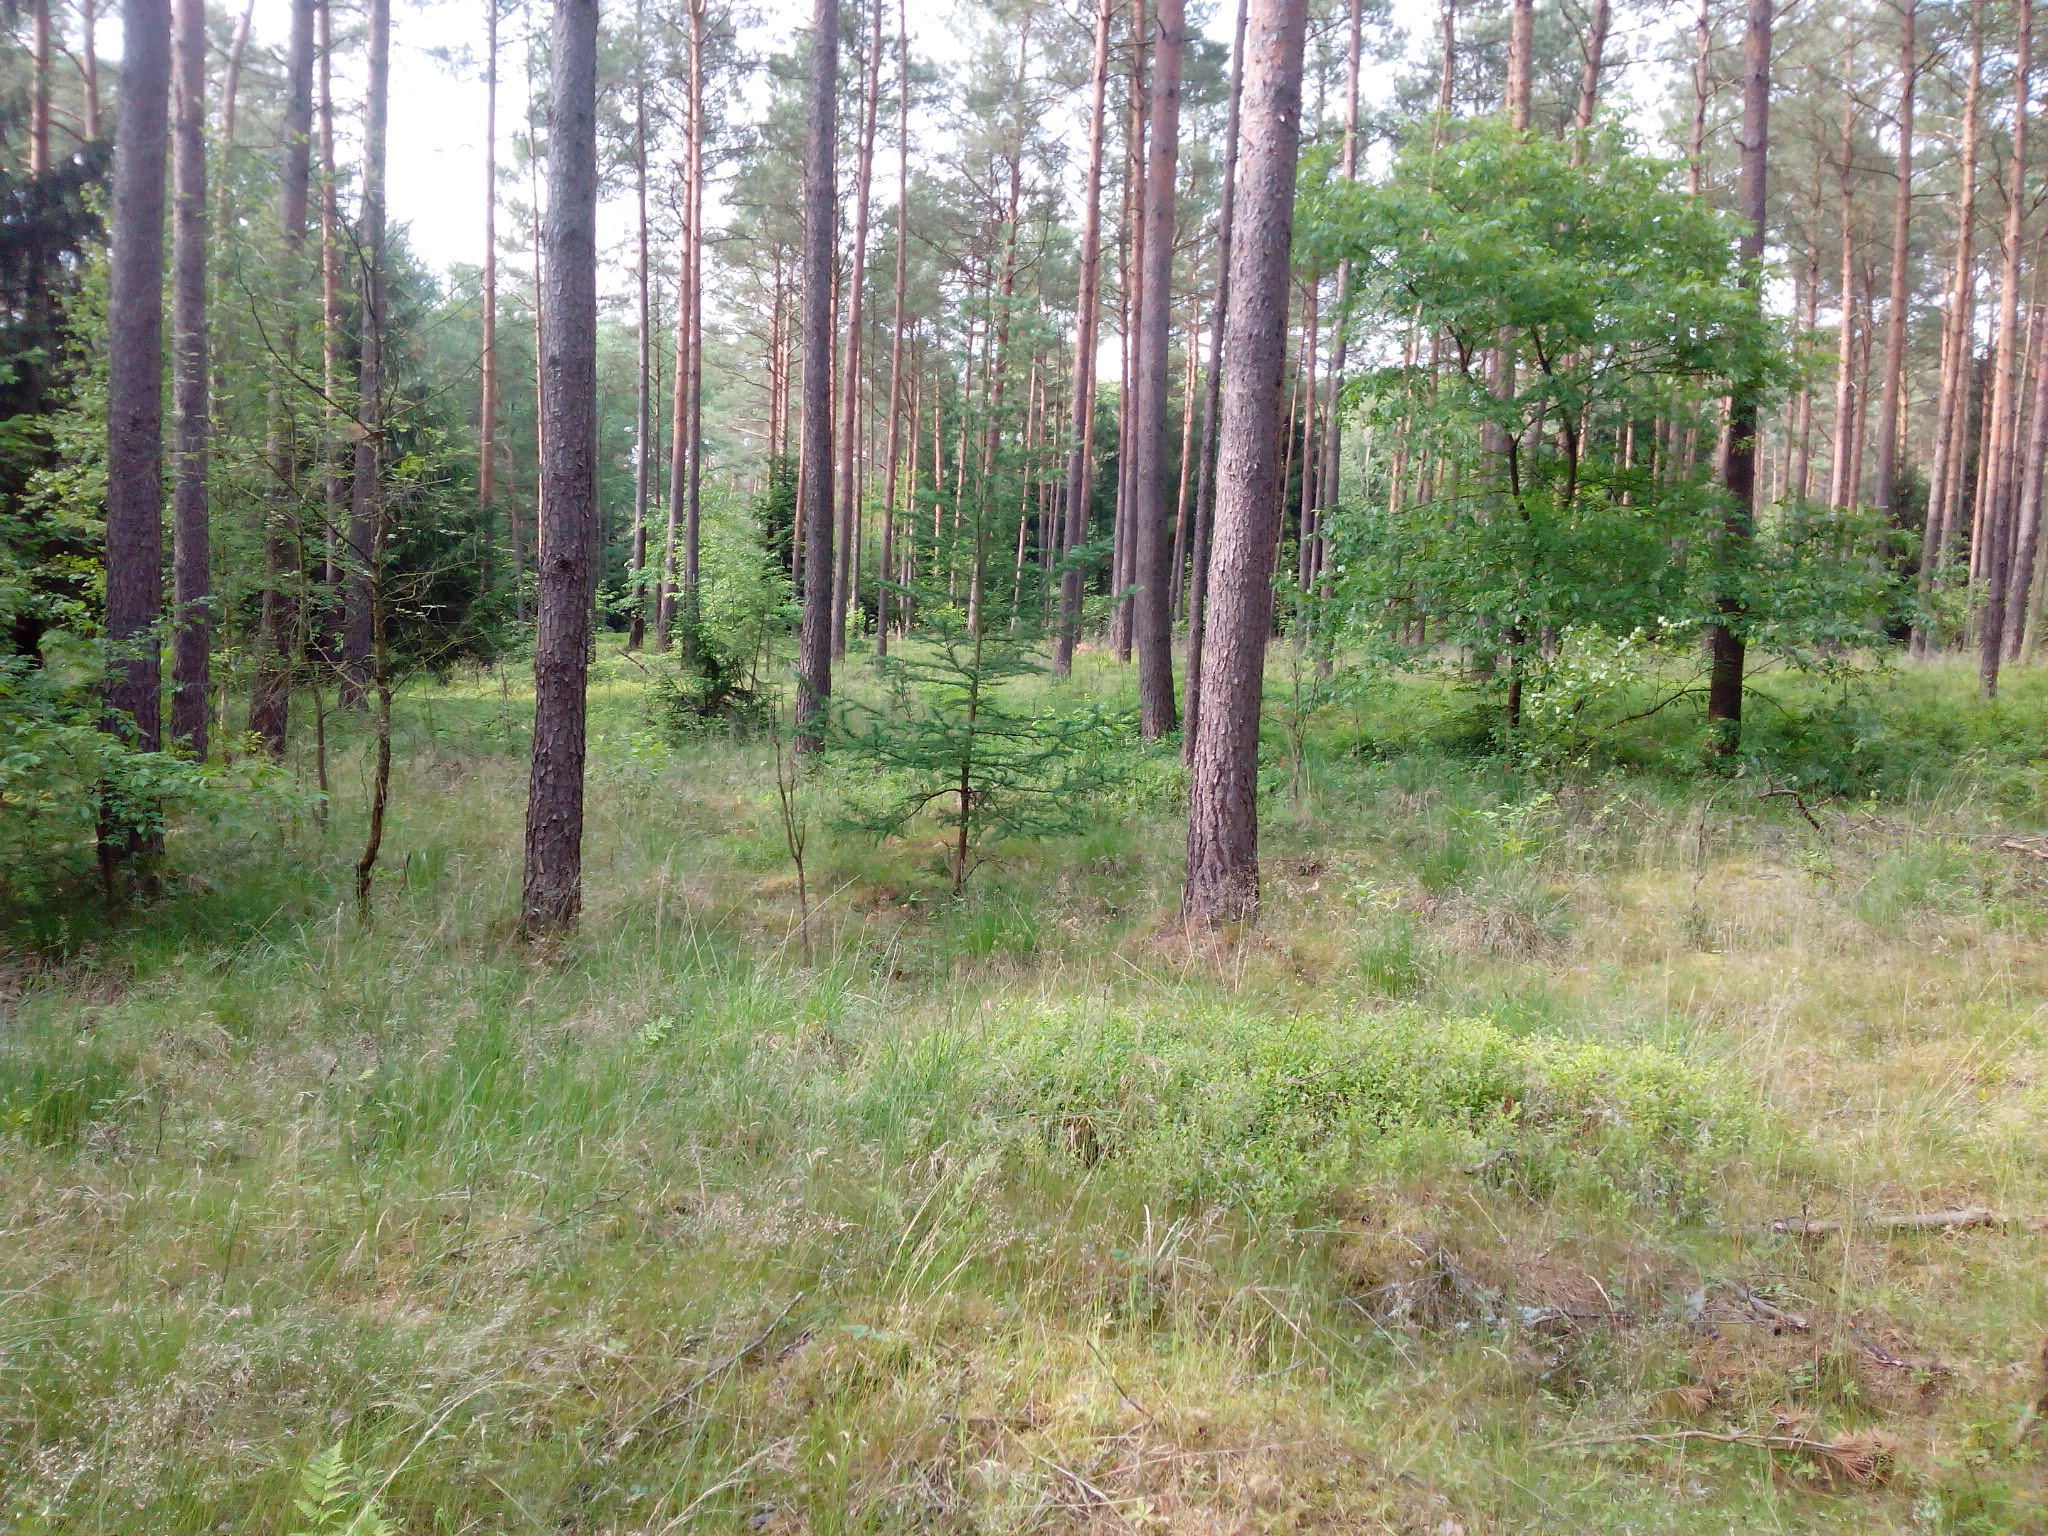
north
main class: Woodland
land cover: Pine dominated coniferous woodland
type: hemiboreal forest and nemoral coniferous forest and mixed broadleaved-coniferous forest
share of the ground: > 75 %
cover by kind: coniferous forest trees 75 %, herbaceous plants 15 %, broadleaved forest trees 5 %, shrubs 5 %
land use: Forestry
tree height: > 5 m
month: June
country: DE
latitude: 52.6290
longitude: 9.8966
